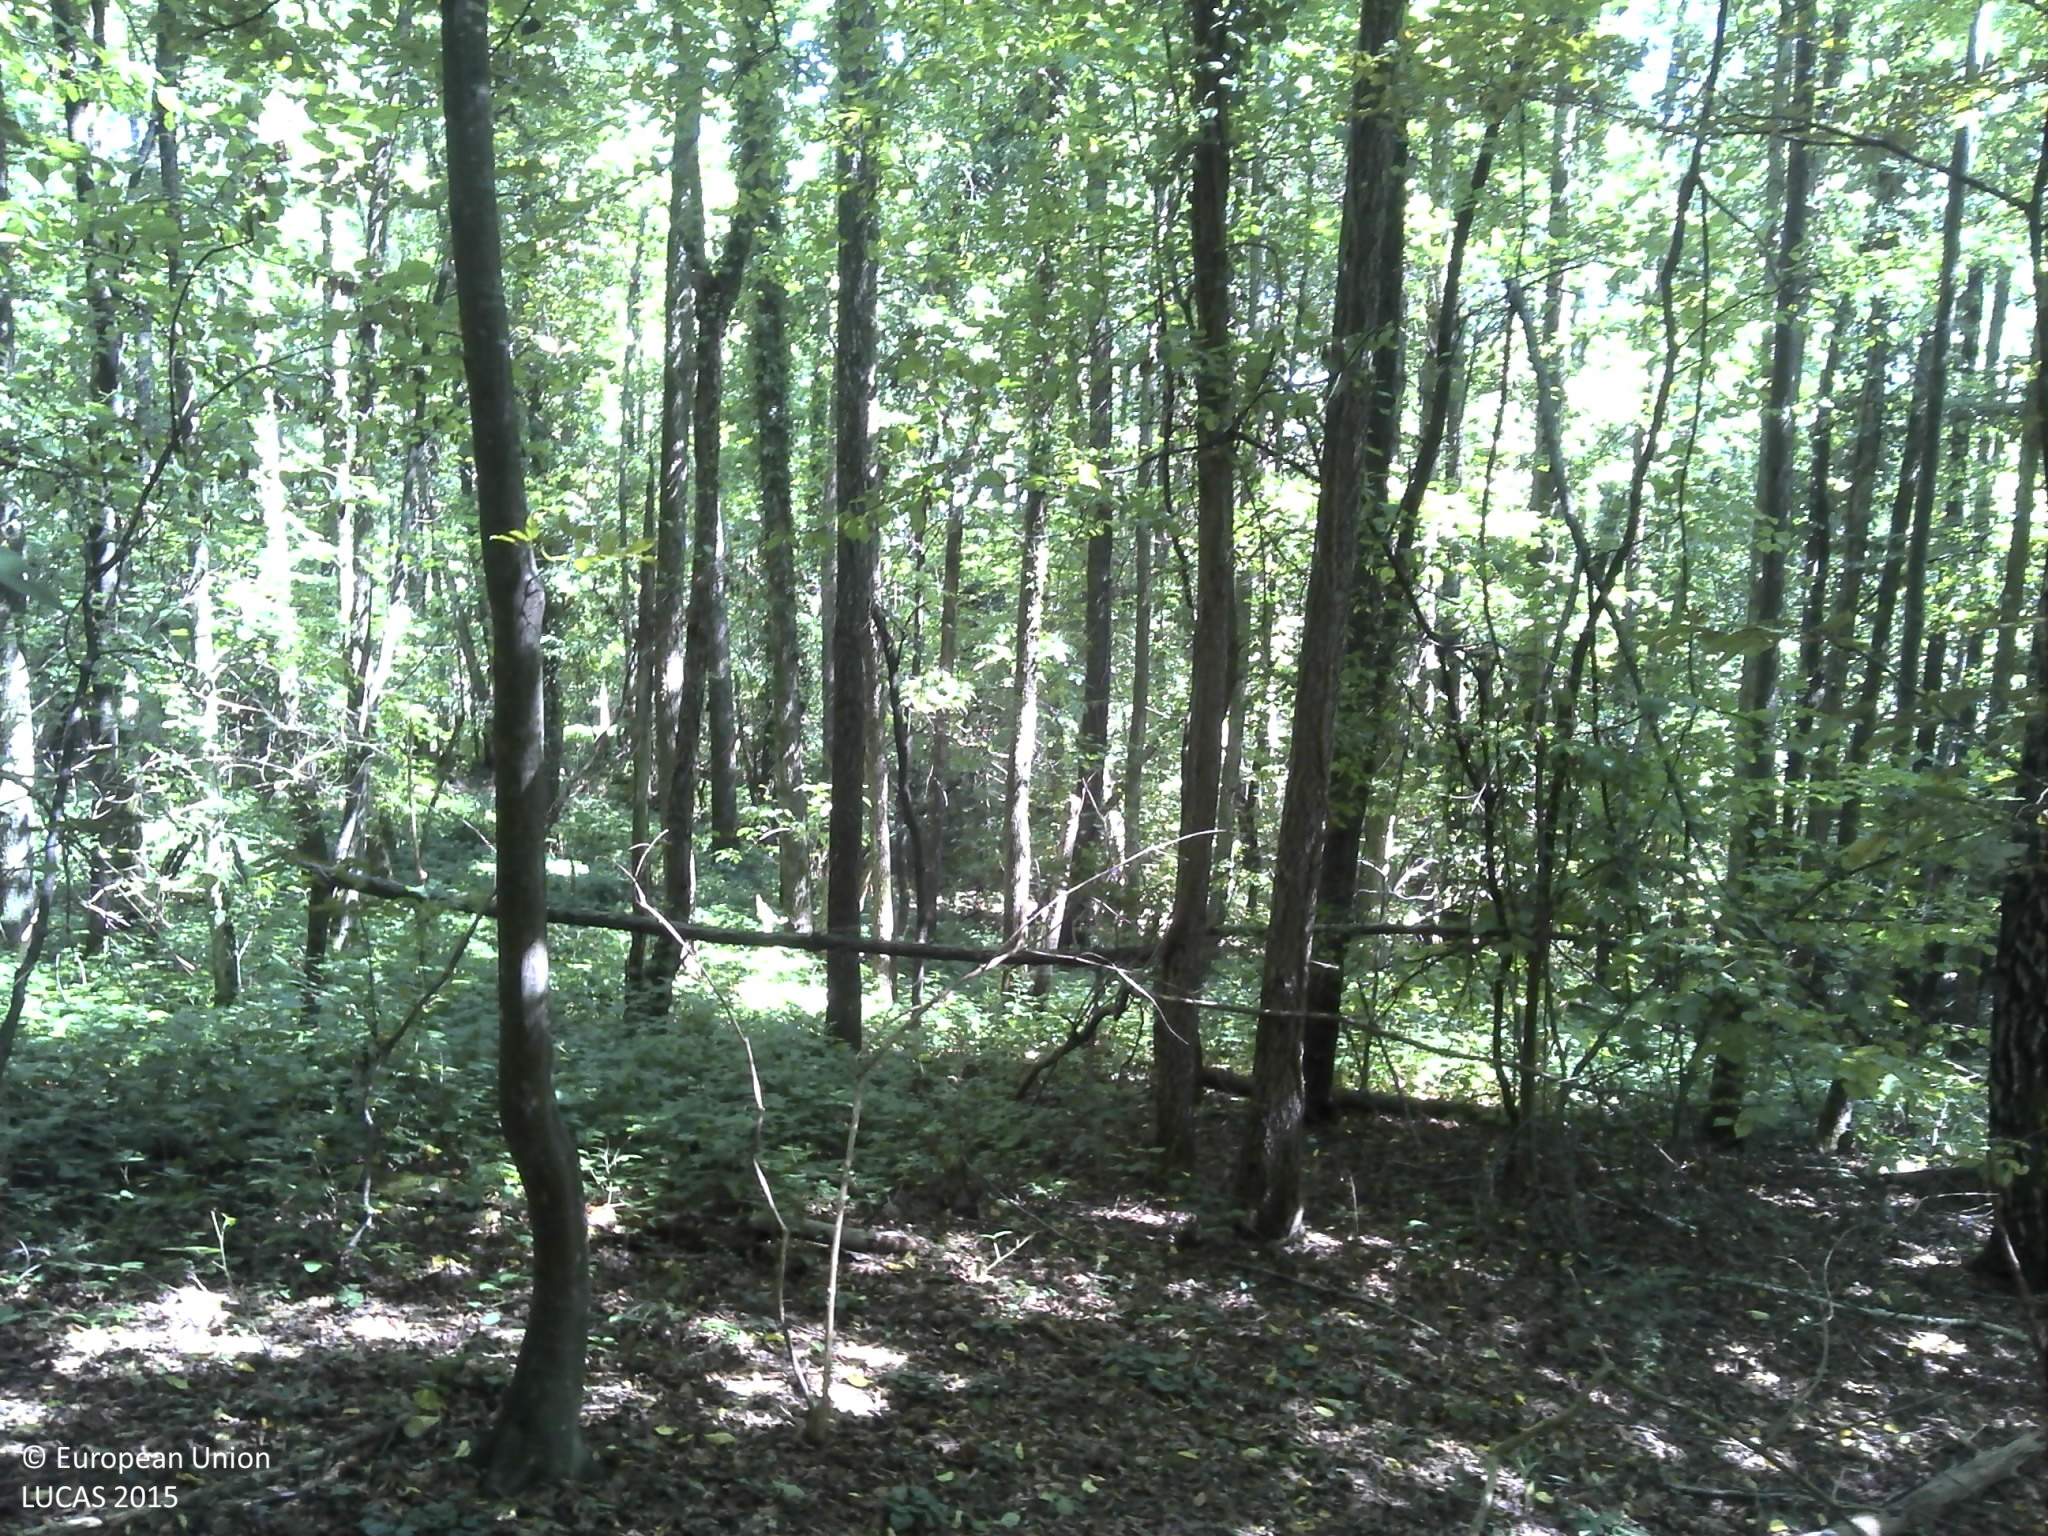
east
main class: Woodland
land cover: Broadleaved woodland
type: beech forest
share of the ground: > 75 %
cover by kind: broadleaved forest trees 100 %
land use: Forestry
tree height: > 5 m
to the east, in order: Broadleaved woodland; Shrubland with sparse tree cover
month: August
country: HR
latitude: 45.2540
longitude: 16.4321
